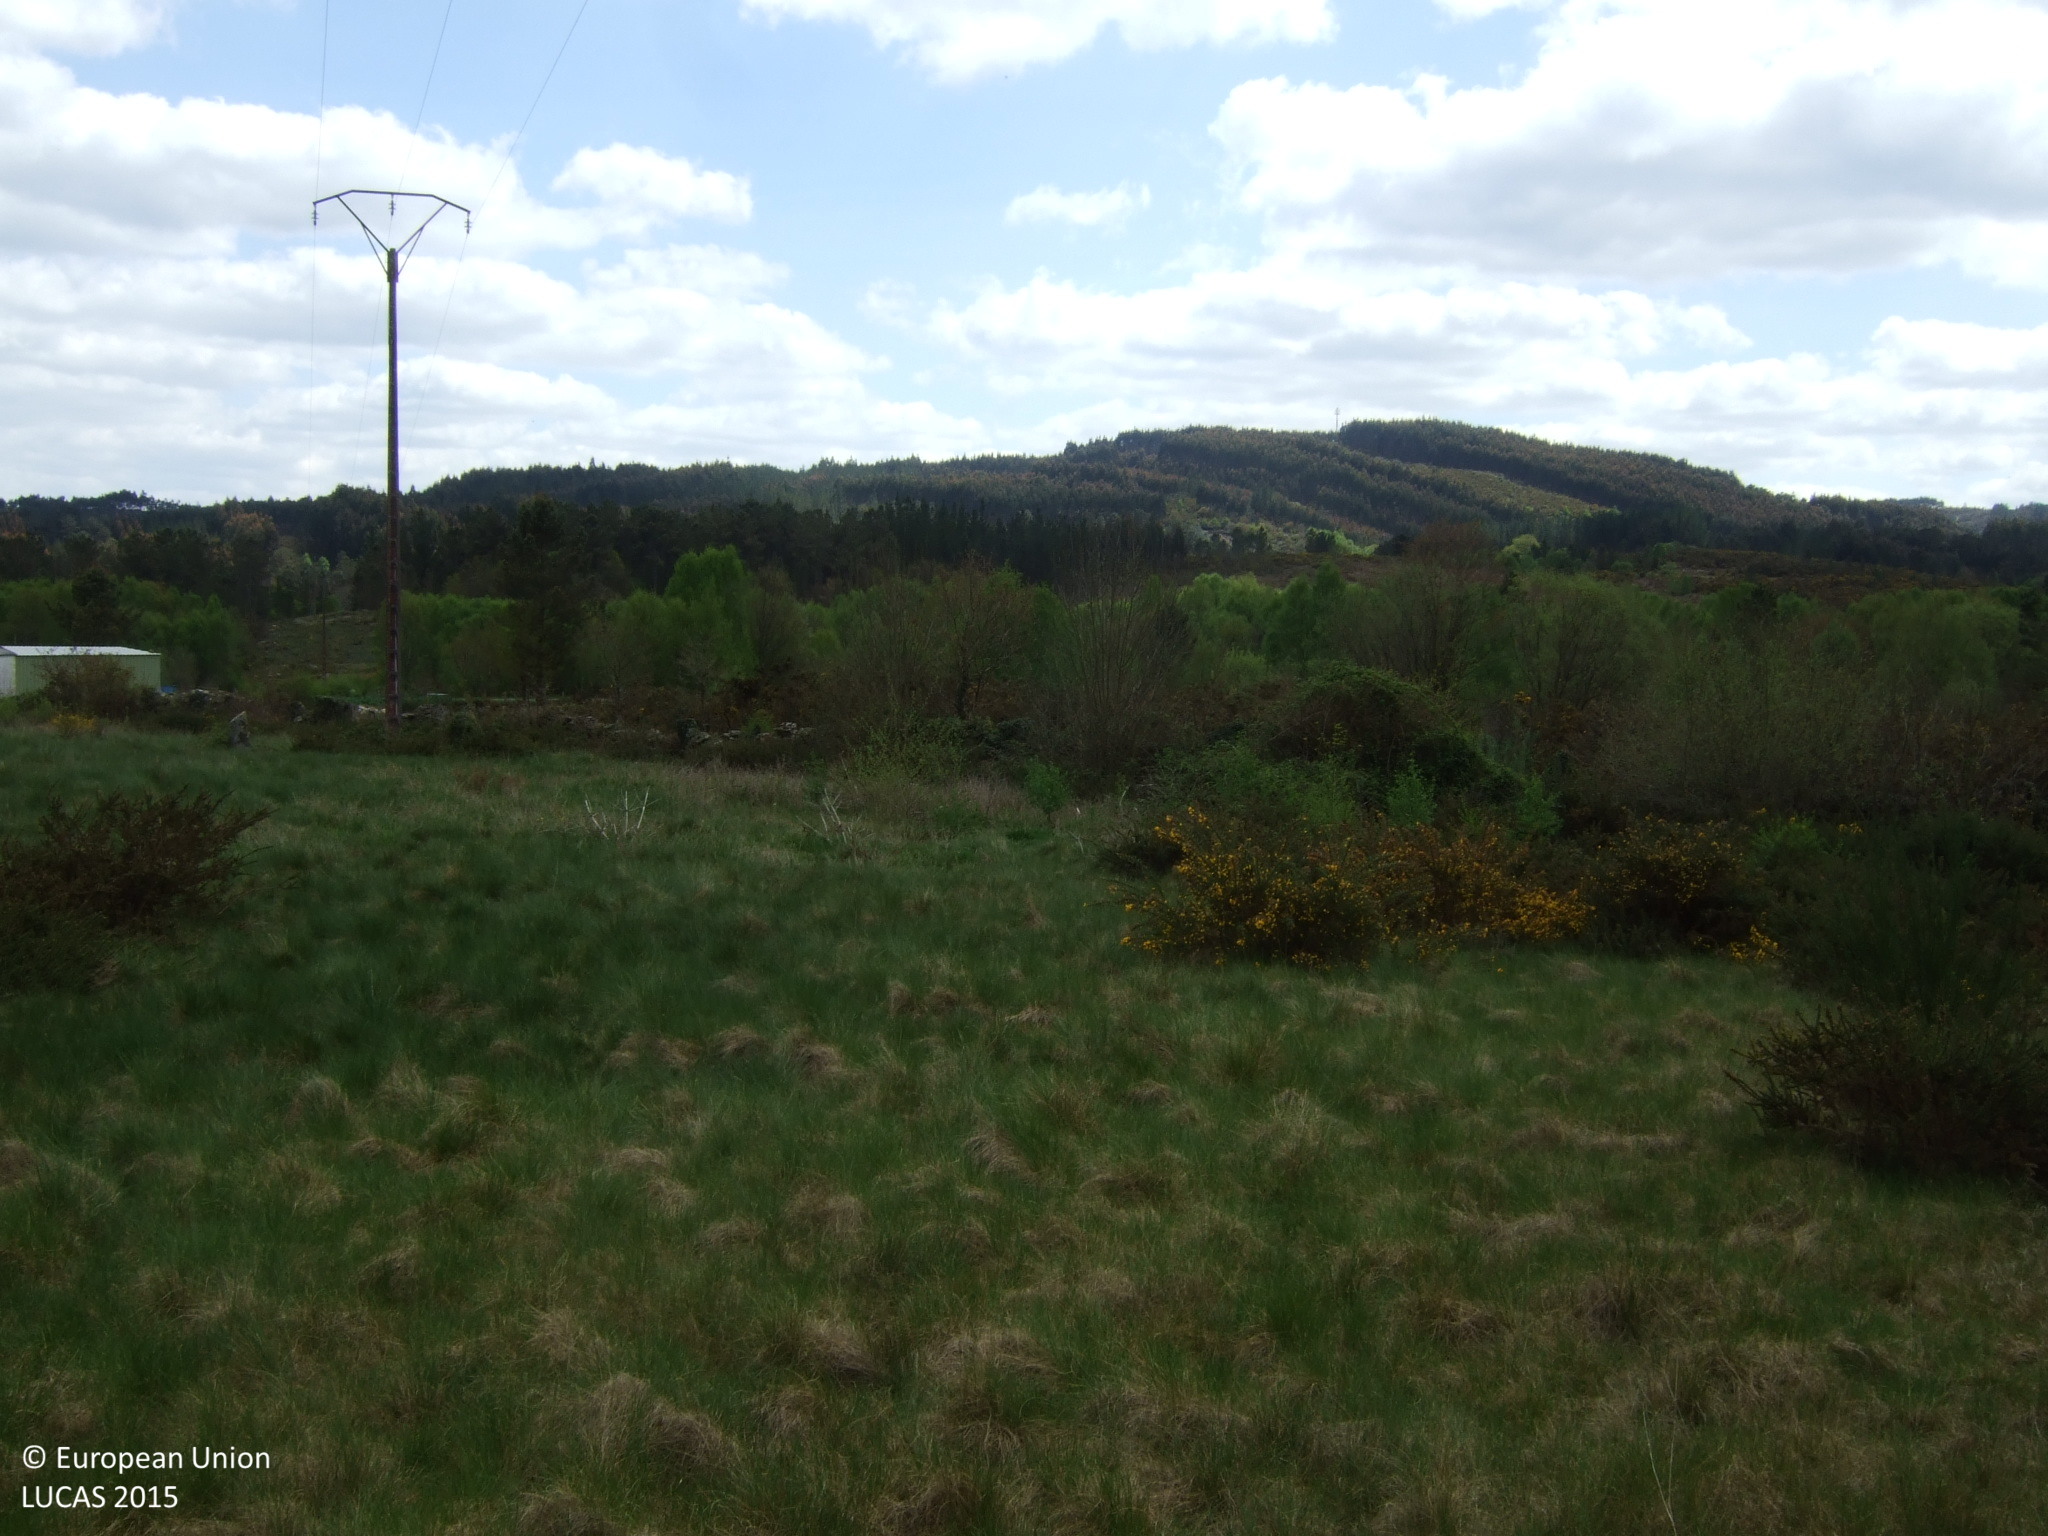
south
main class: Grassland
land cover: Grassland without tree/shrub cover
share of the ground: > 75 %
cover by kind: herbaceous plants 95 %, shrubs 5 %
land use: Semi-natural and natural areas not in use
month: April
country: ES
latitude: 43.1279
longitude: -7.6974
